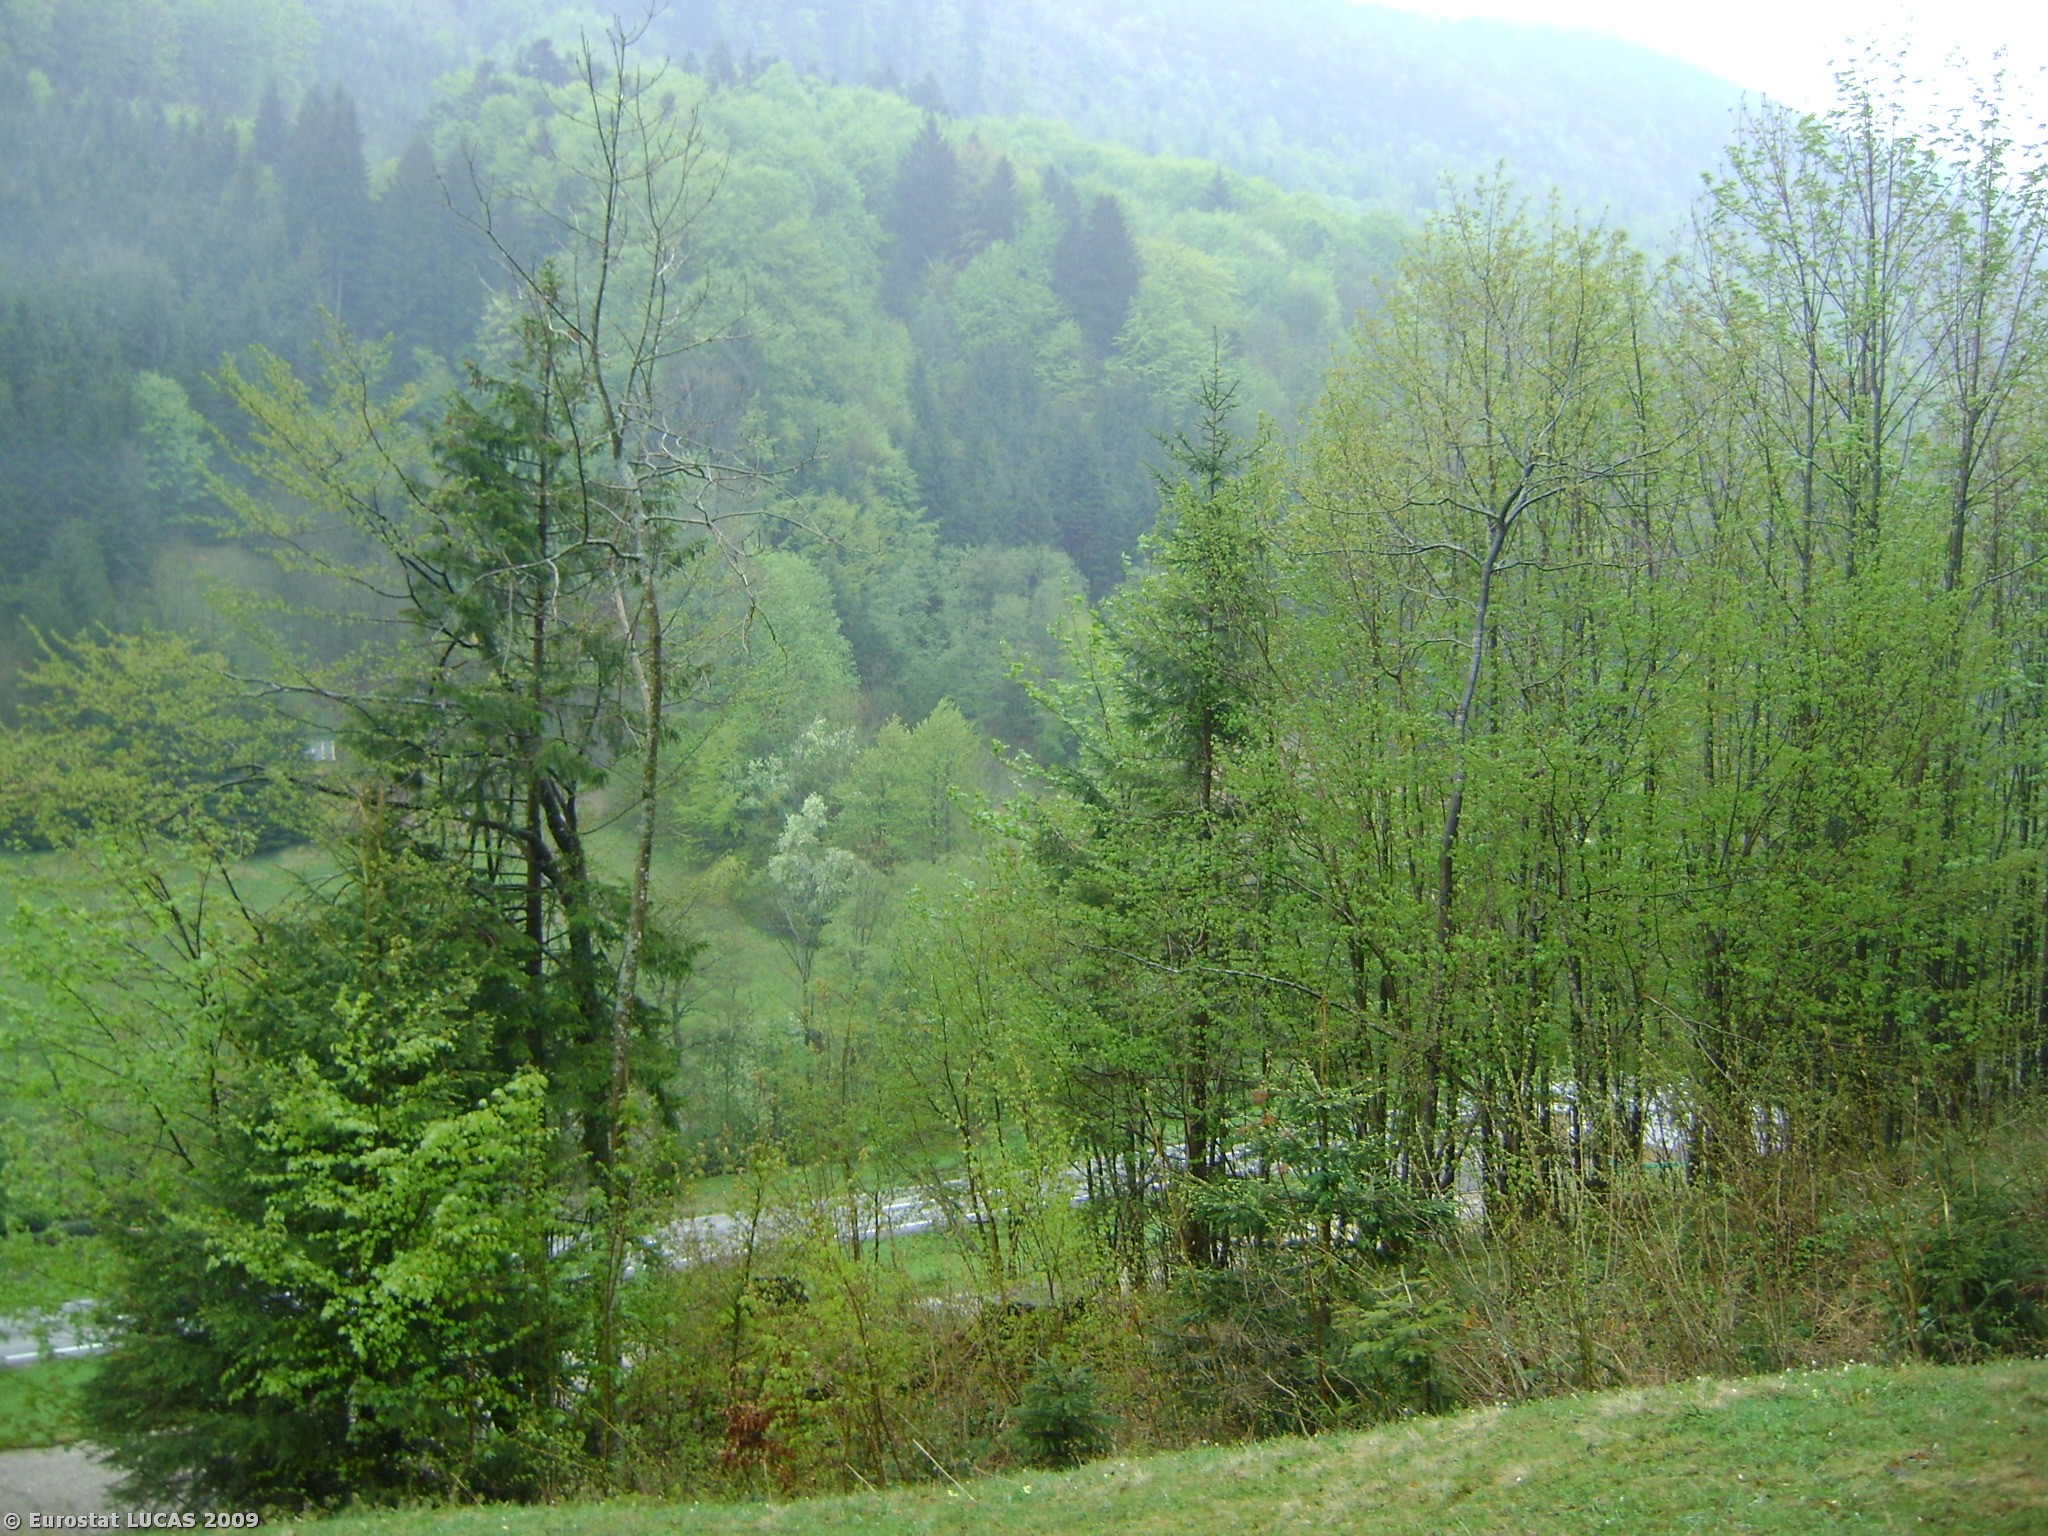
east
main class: Grassland
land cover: Grassland without tree/shrub cover
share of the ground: > 75 %
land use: Agriculture (excluding fallow land and kitchen gardens)
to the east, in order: Grassland without tree/shrub cover; Electric lines; Grassland without tree/shrub cover; Mixed woodland; Grassland without tree/shrub cover; Paved roads, cycling and walking lanes; Grassland without tree/shrub cover; Paved roads, cycling and walking lanes; Grassland without tree/shrub cover; Mixed woodland; Rivers and streams; Mixed woodland; Grassland without tree/shrub cover; Mixed woodland
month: May
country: AT
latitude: 47.7976
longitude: 13.2429
